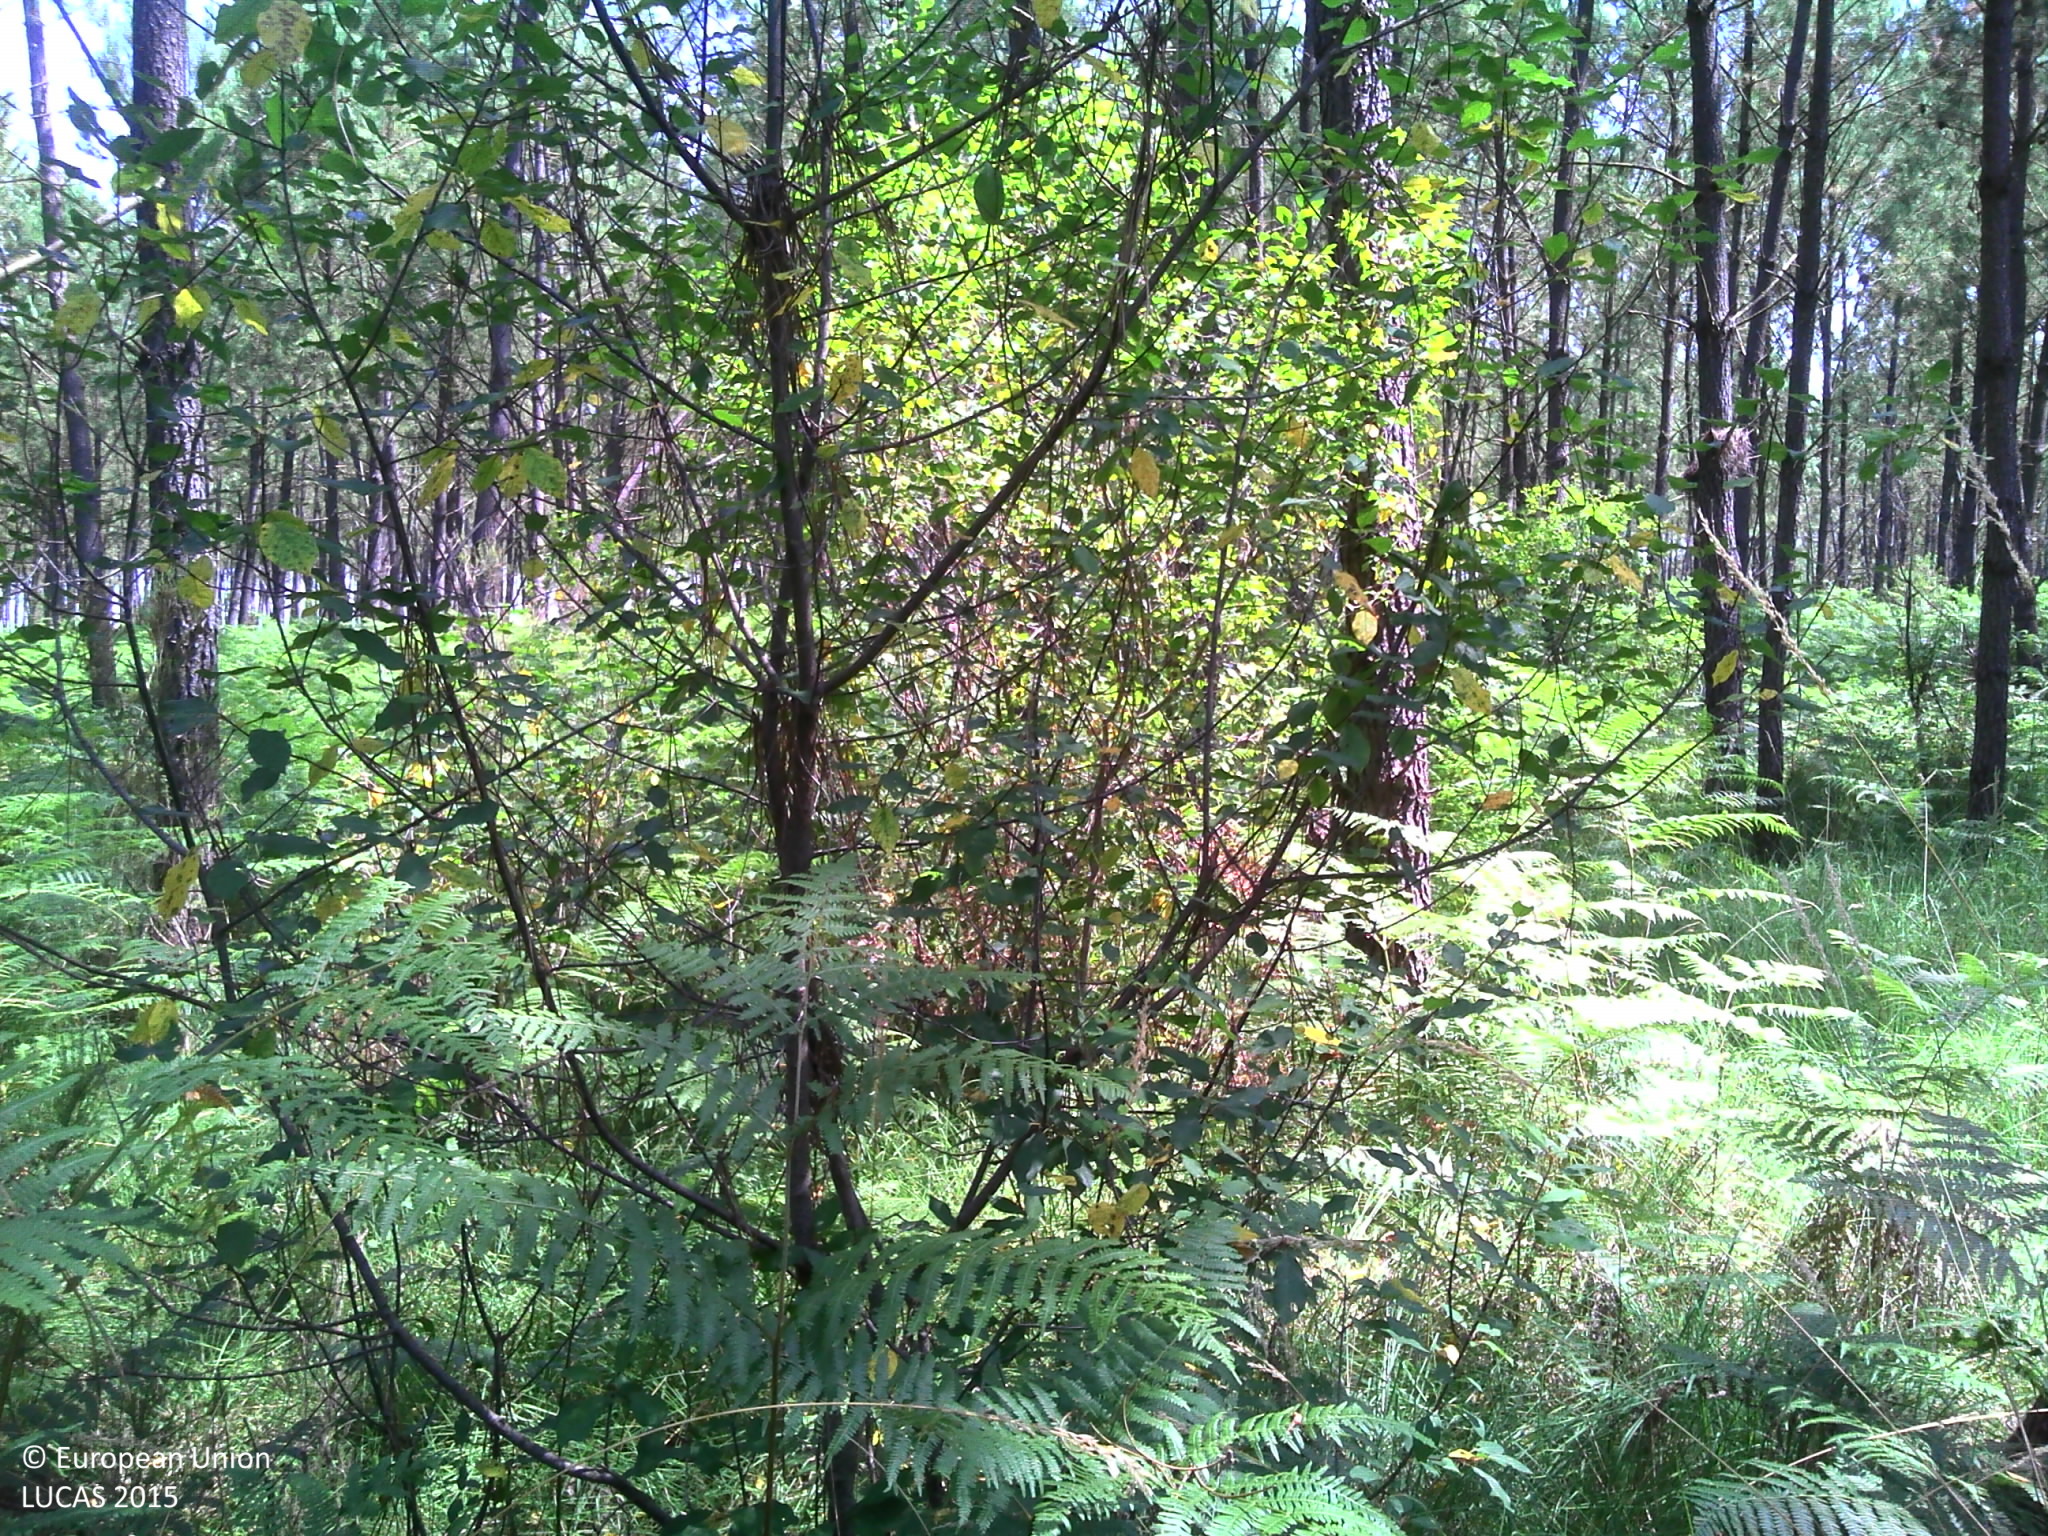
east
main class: Woodland
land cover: Pine dominated coniferous woodland
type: coniferous forest of the mediterranean region
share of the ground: > 75 %
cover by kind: coniferous forest trees 75 %, herbaceous plants 20 %, shrubs 5 %
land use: Forestry
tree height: > 5 m
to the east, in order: Pine dominated coniferous woodland; Abandoned hedges; Ditches and canals; Grass margins; Tracks
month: July
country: FR
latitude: 44.2733
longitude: -0.6525
